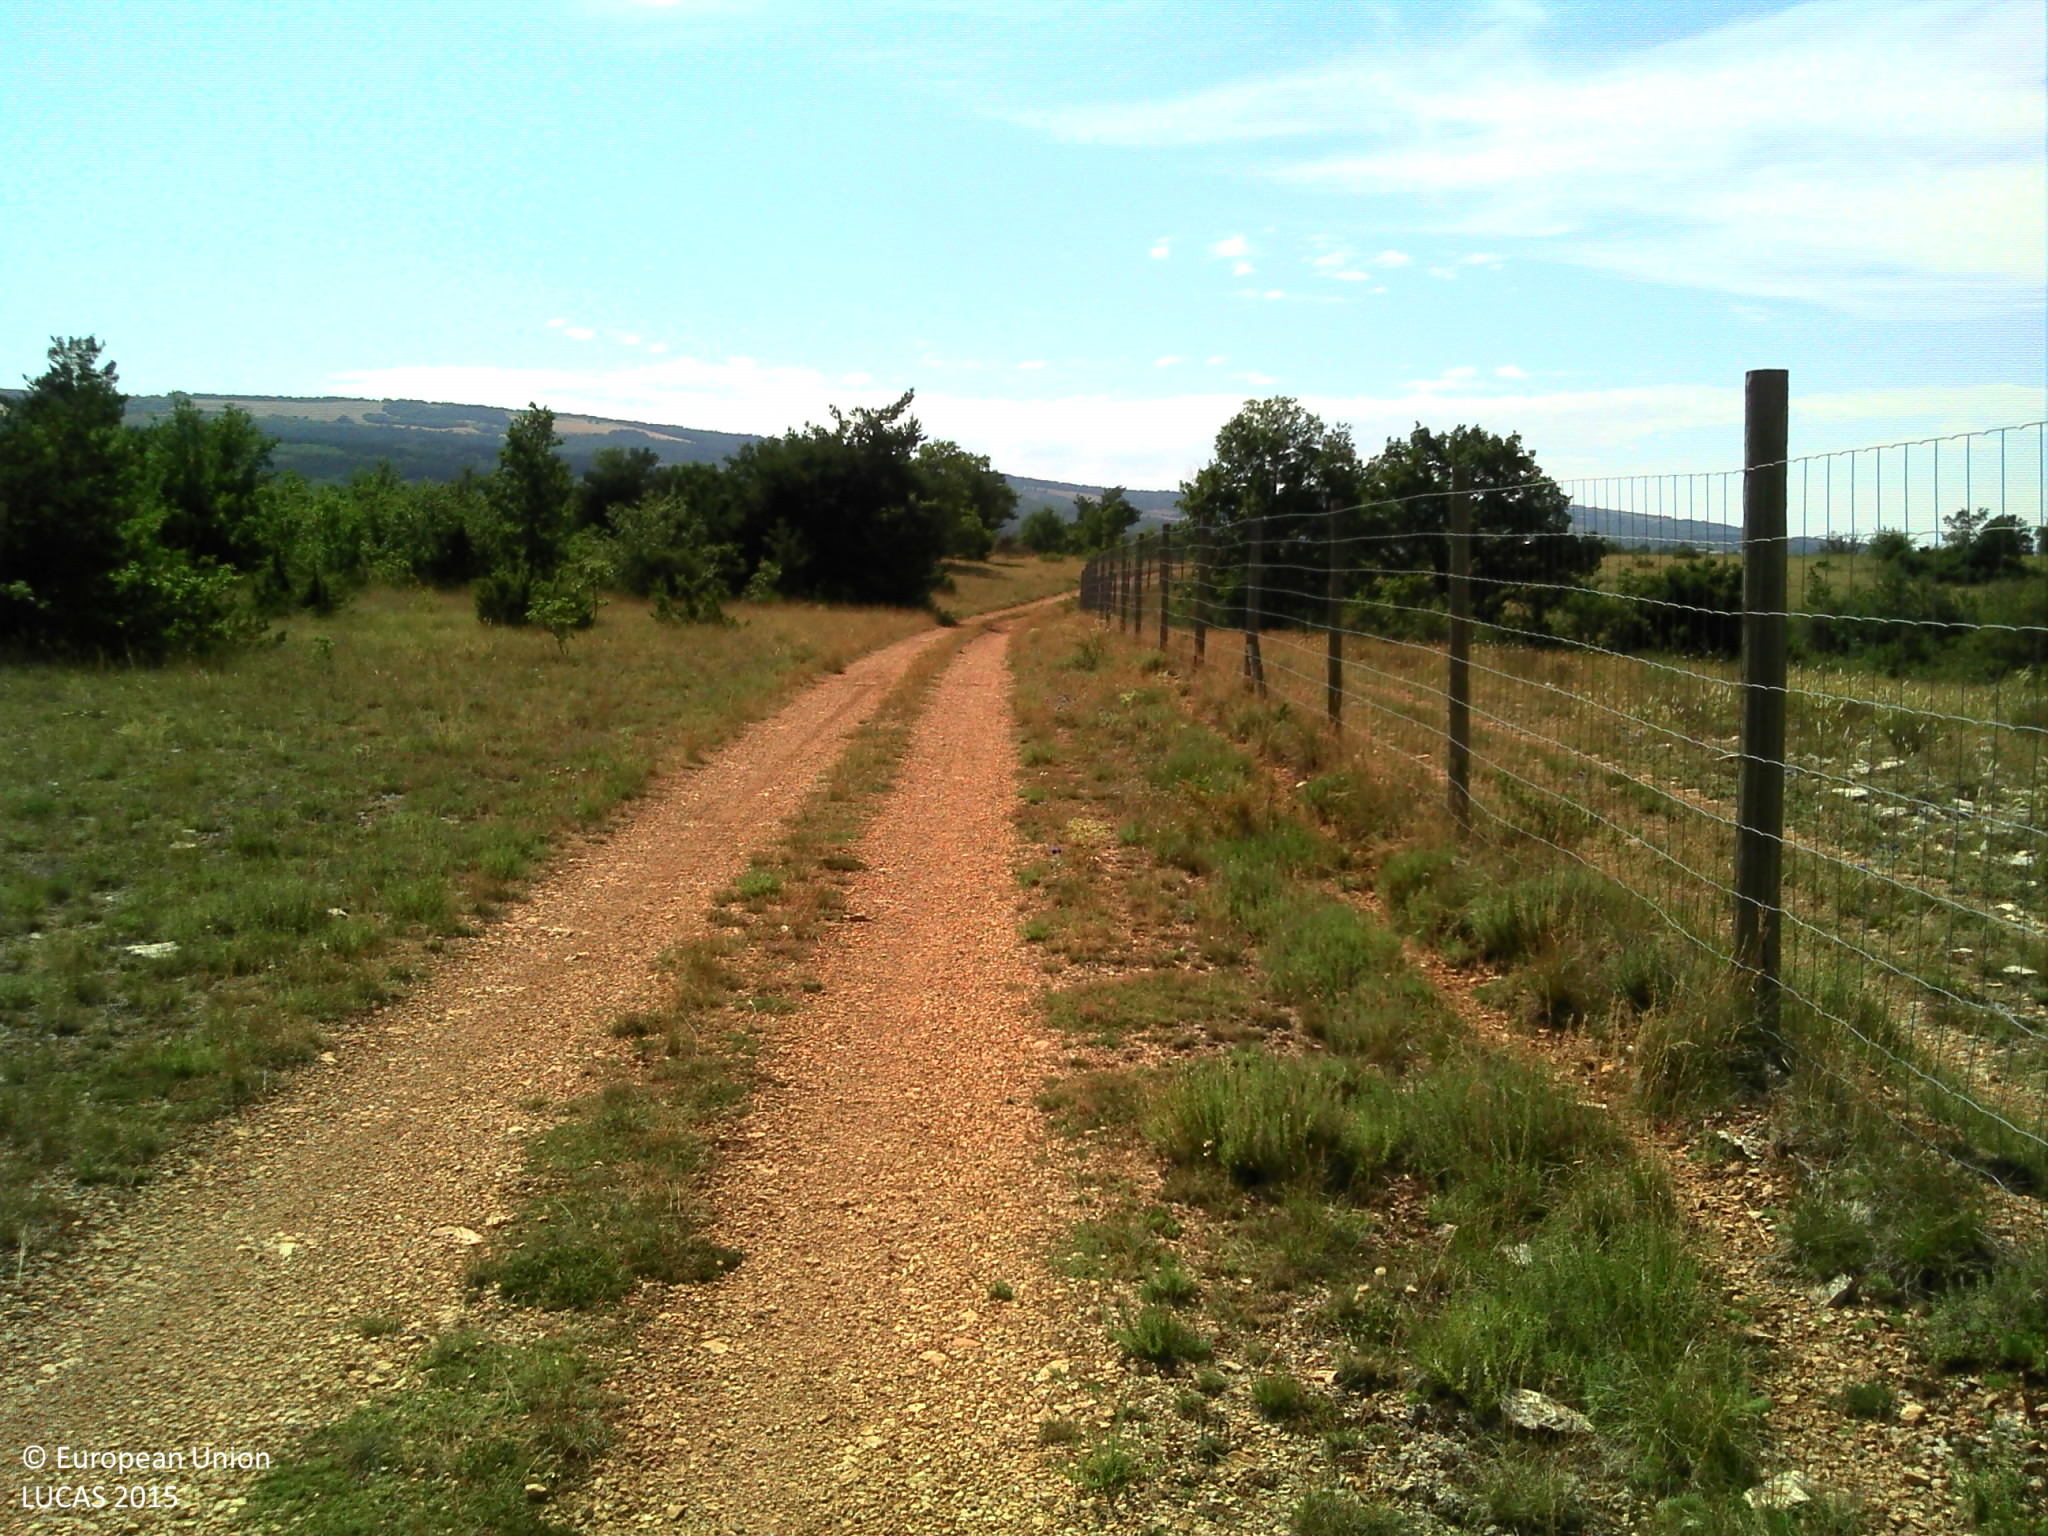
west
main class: Grassland
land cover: Spontaneously vegetated surfaces
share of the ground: > 75 %
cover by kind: herbaceous plants 70 %, unconsolidated bare surface 25 %, shrubs 5 %
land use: Semi-natural and natural areas not in use
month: July
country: FR
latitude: 44.0194
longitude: 5.5297
